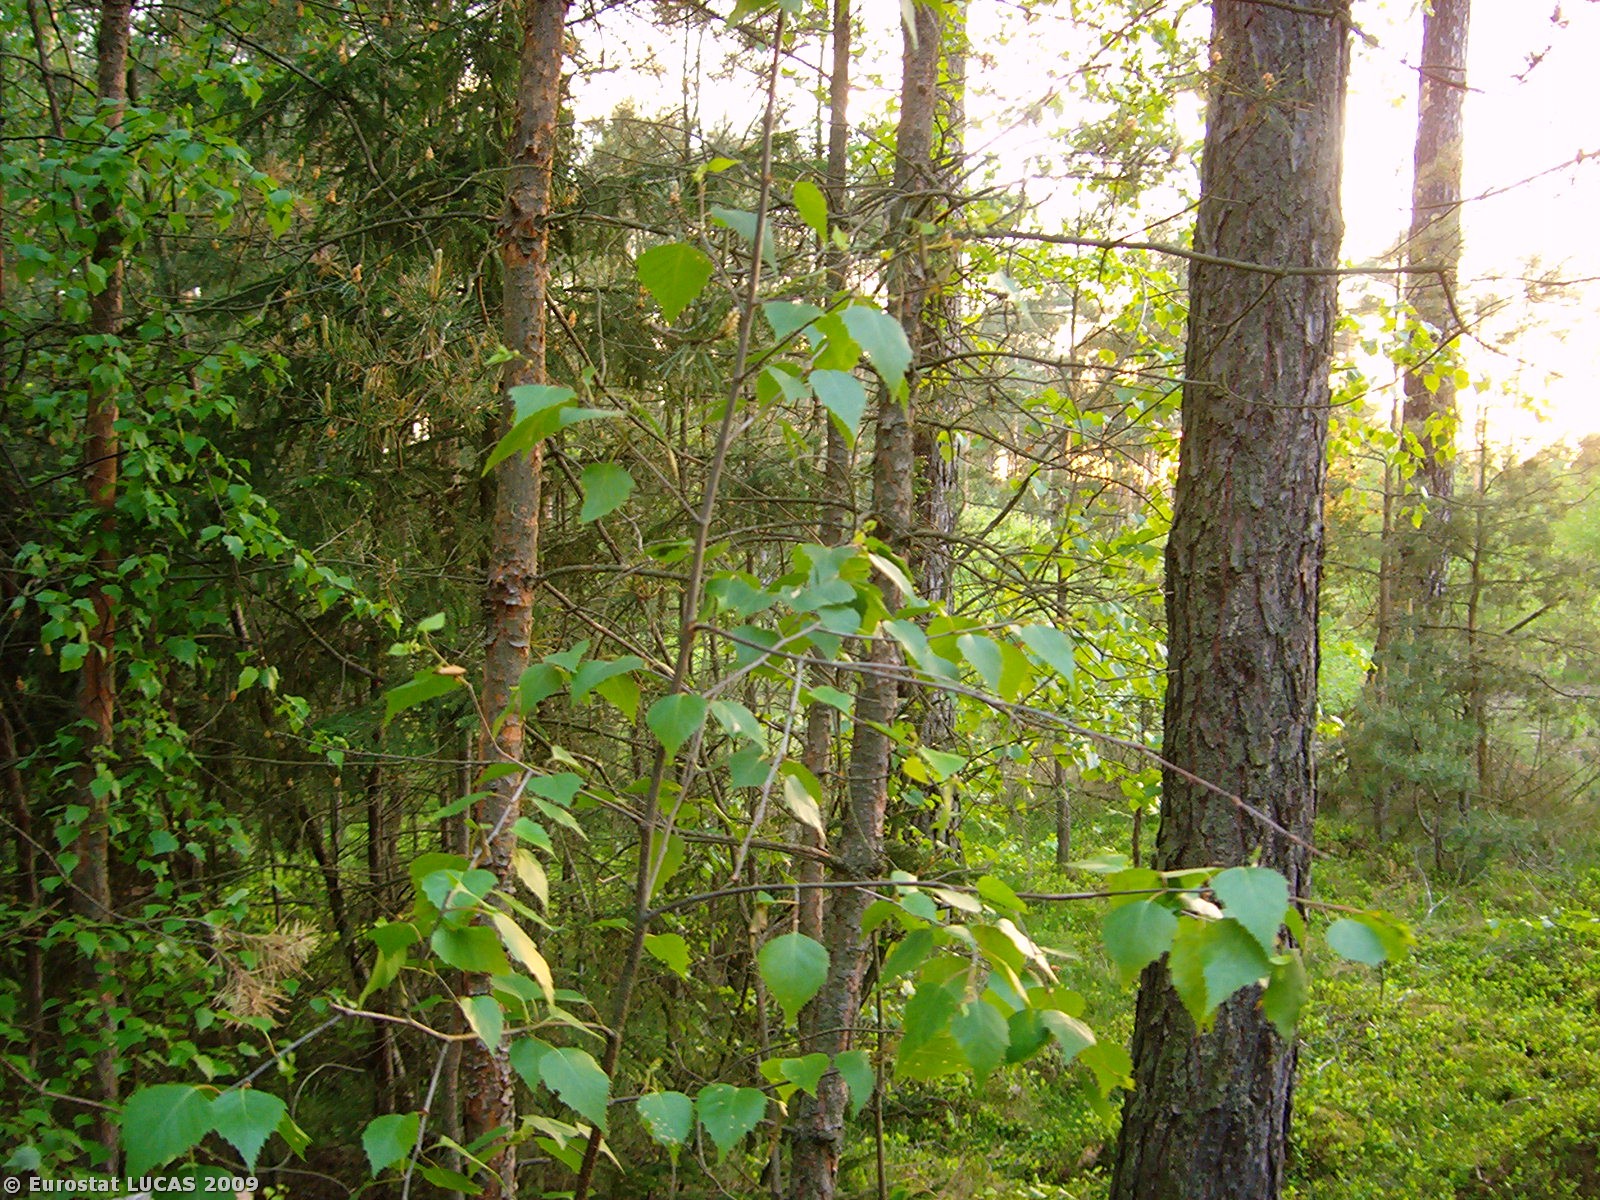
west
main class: Woodland
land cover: Mixed woodland
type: hemiboreal forest and nemoral coniferous forest and mixed broadleaved-coniferous forest
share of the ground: 50 - 75 %
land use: Forestry
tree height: > 5 m
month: May
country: PL
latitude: 52.5836
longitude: 16.3976
